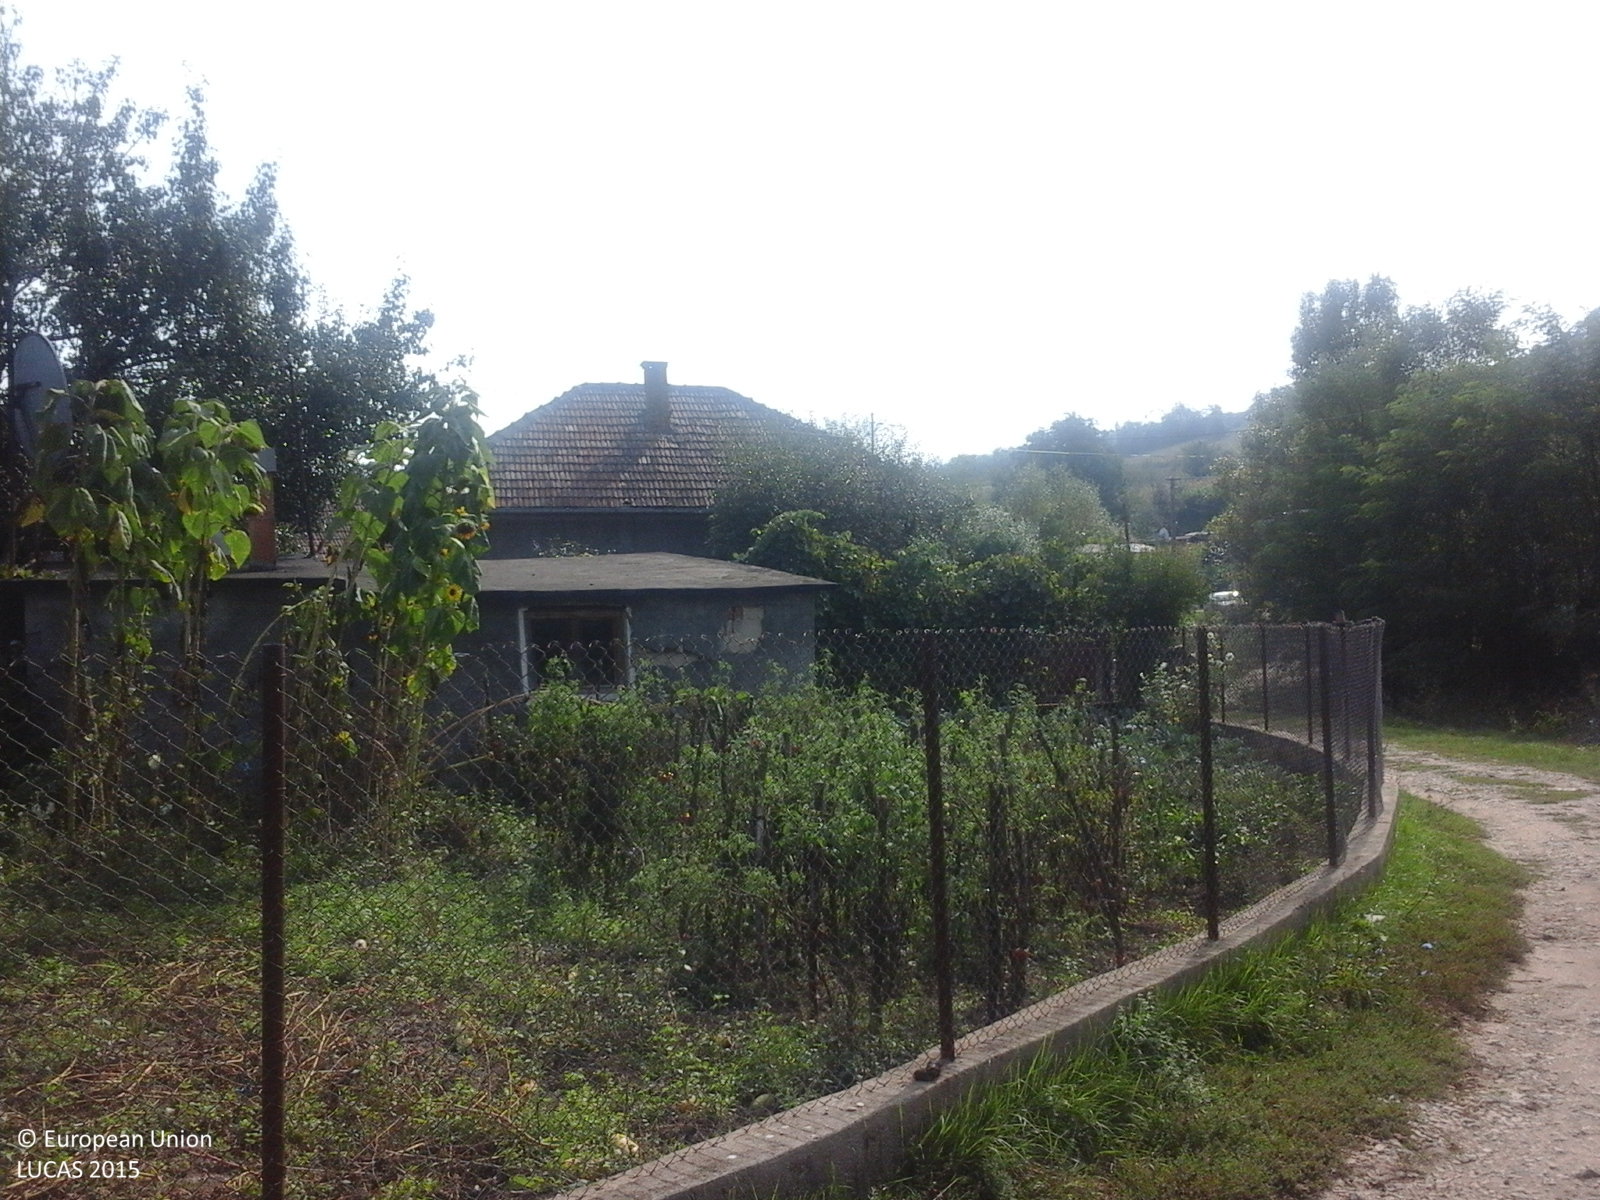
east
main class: Cropland
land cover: Maize
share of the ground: > 75 %
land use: Kitchen garden
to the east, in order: Maize; Artificial constructions in urban areas; Sunflower; Abandoned hedges; Ditches and canals; Abandoned hedges; Maize; Potatoes; Maize; Artificial constructions in urban areas
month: September
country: RO
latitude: 47.1052
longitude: 23.2842
